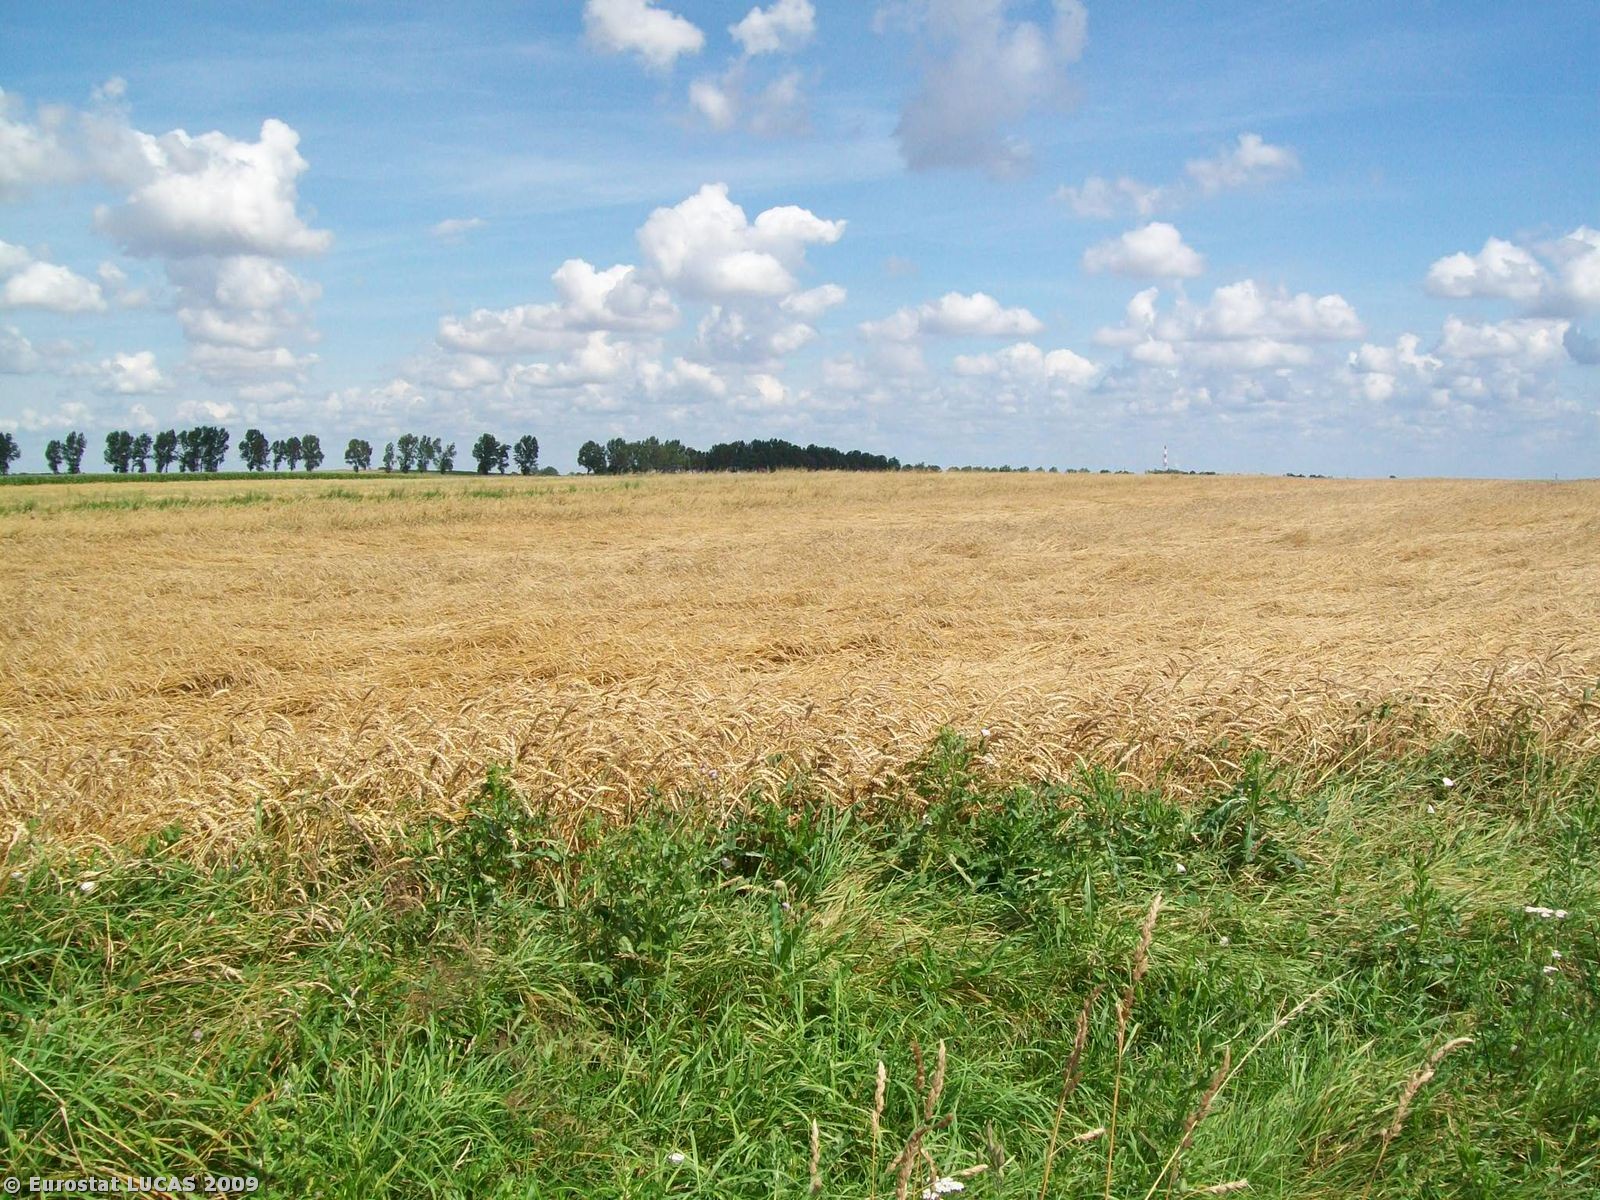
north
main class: Cropland
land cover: Common wheat
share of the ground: > 75 %
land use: Agriculture (excluding fallow land and kitchen gardens)
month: July
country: PL
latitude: 51.1205
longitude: 16.1068
